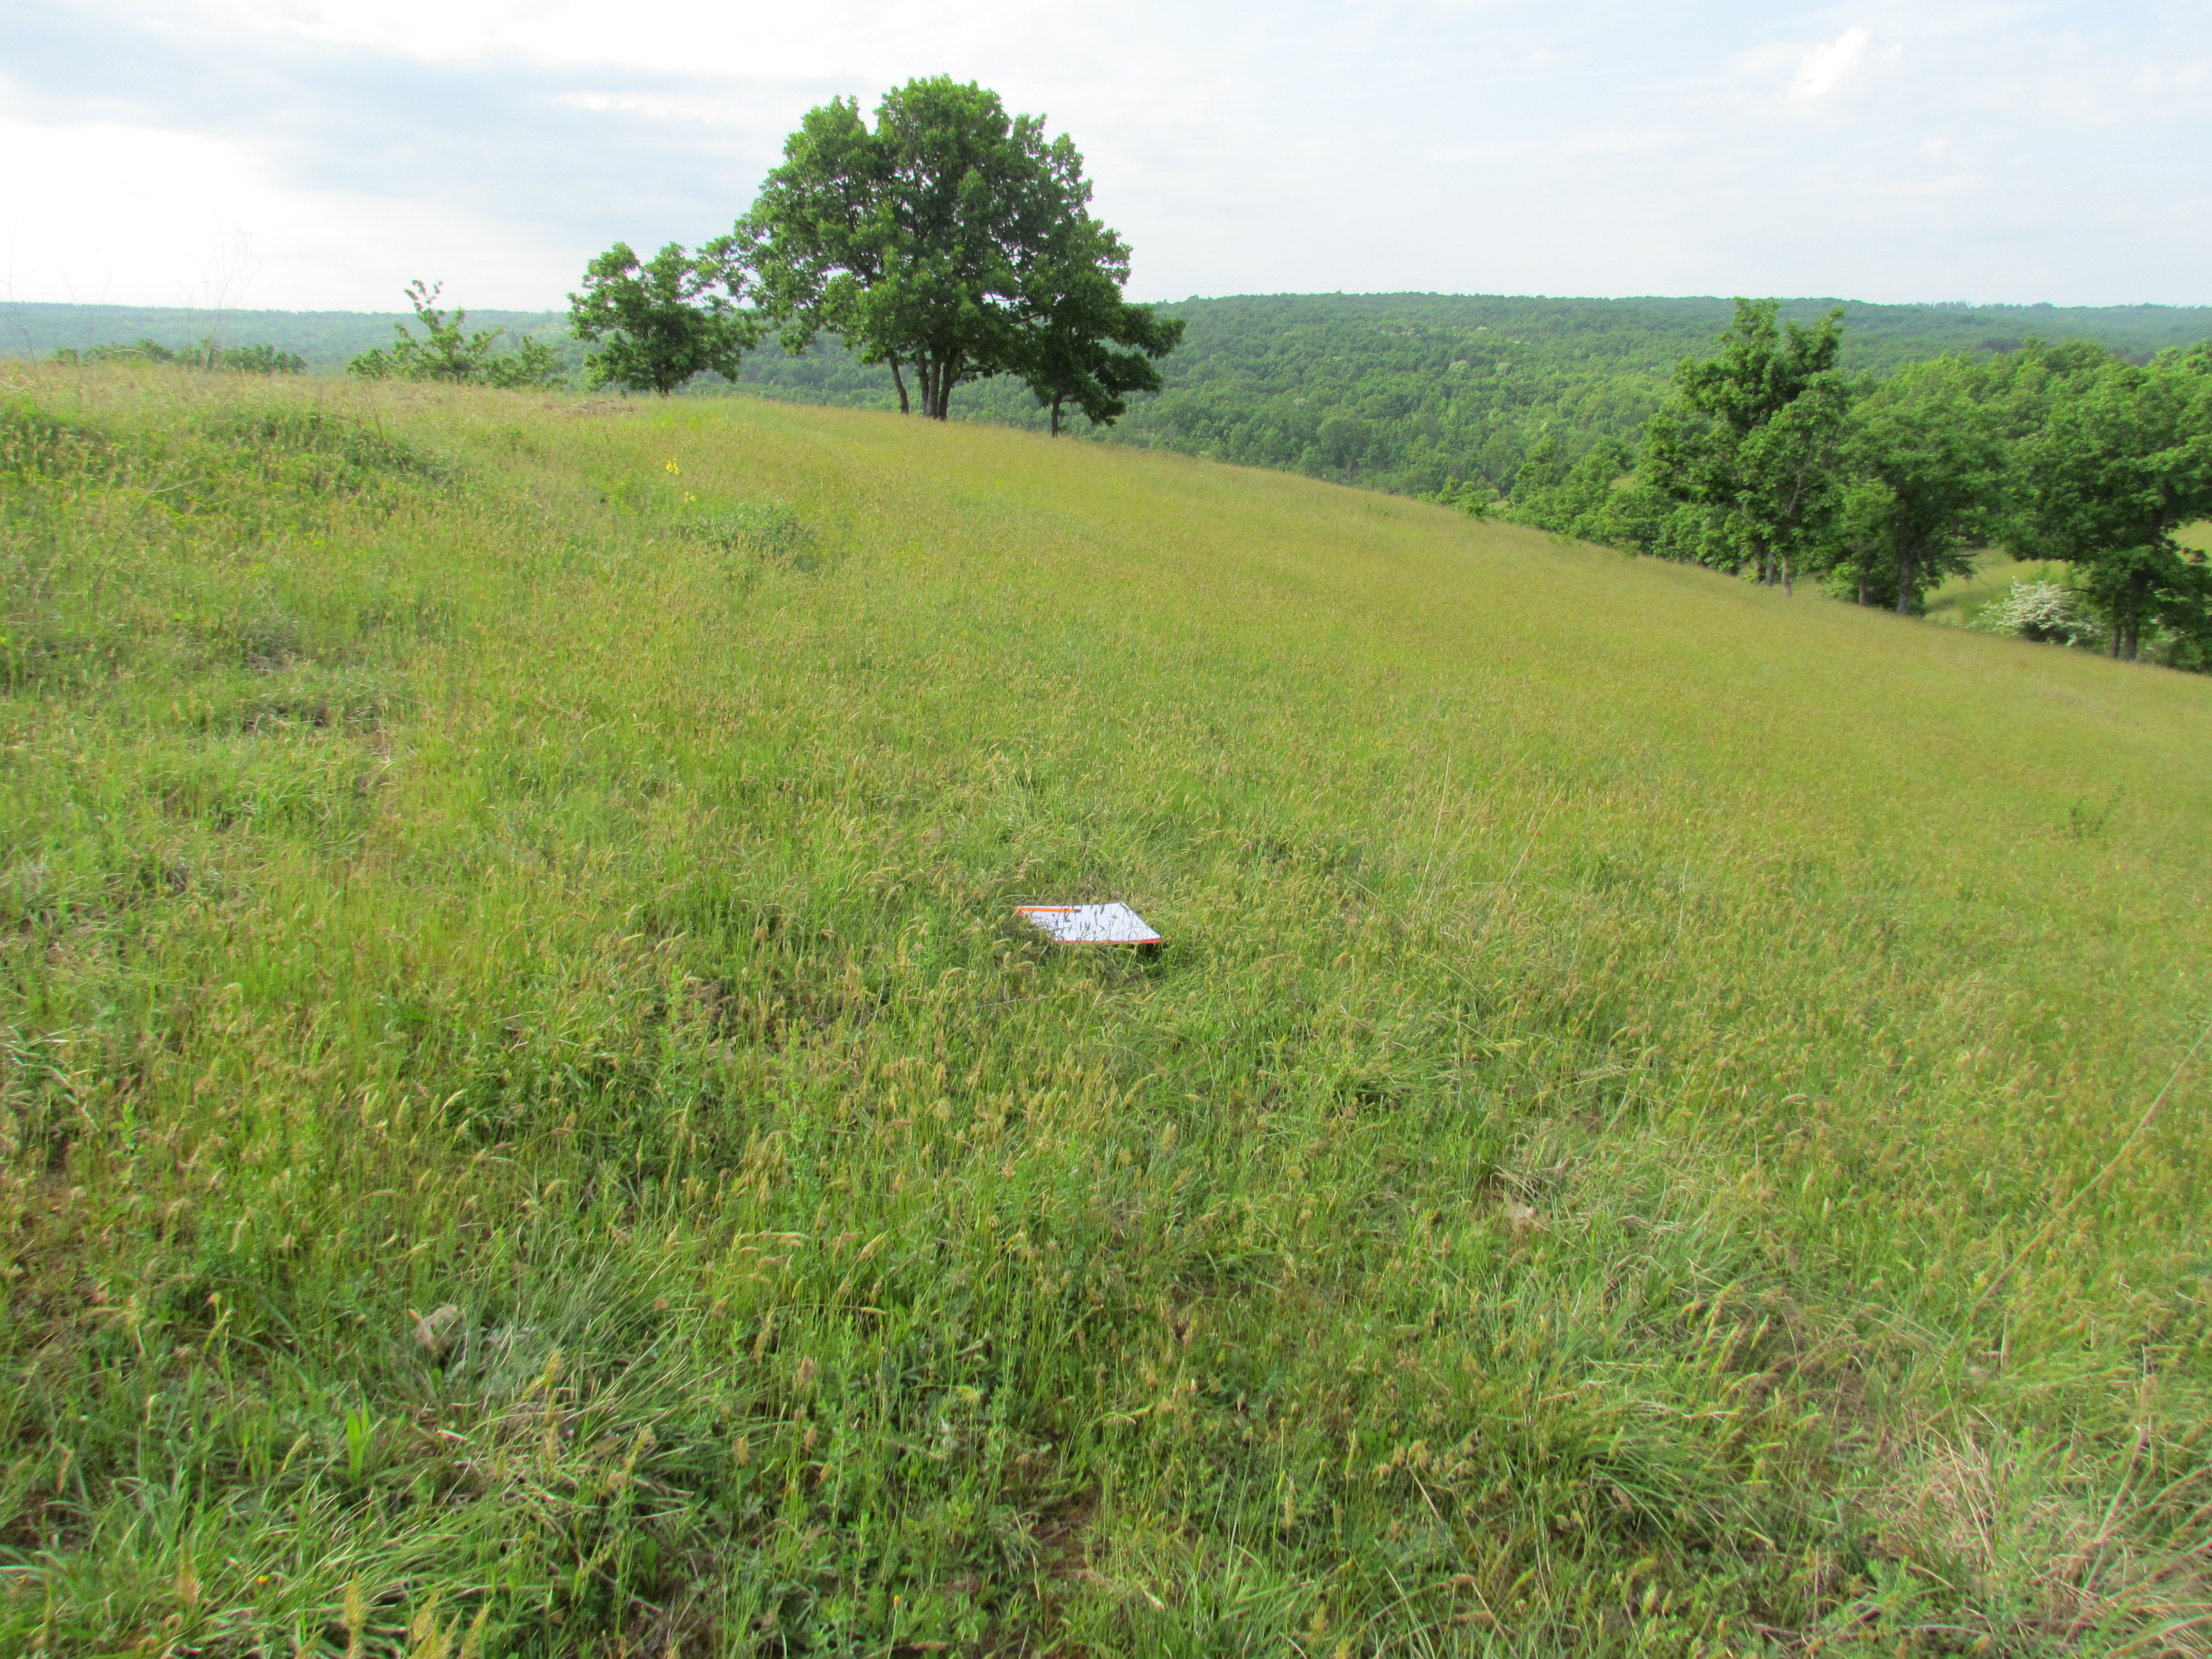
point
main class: Grassland
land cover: Grassland with sparse tree/shrub cover
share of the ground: > 75 %
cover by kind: herbaceous plants 90 %, broadleaved forest trees 5 %, shrubs 5 %
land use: Agriculture (excluding fallow land and kitchen gardens)
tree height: > 5 m
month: May
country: BG
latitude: 42.2630
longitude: 27.1624
